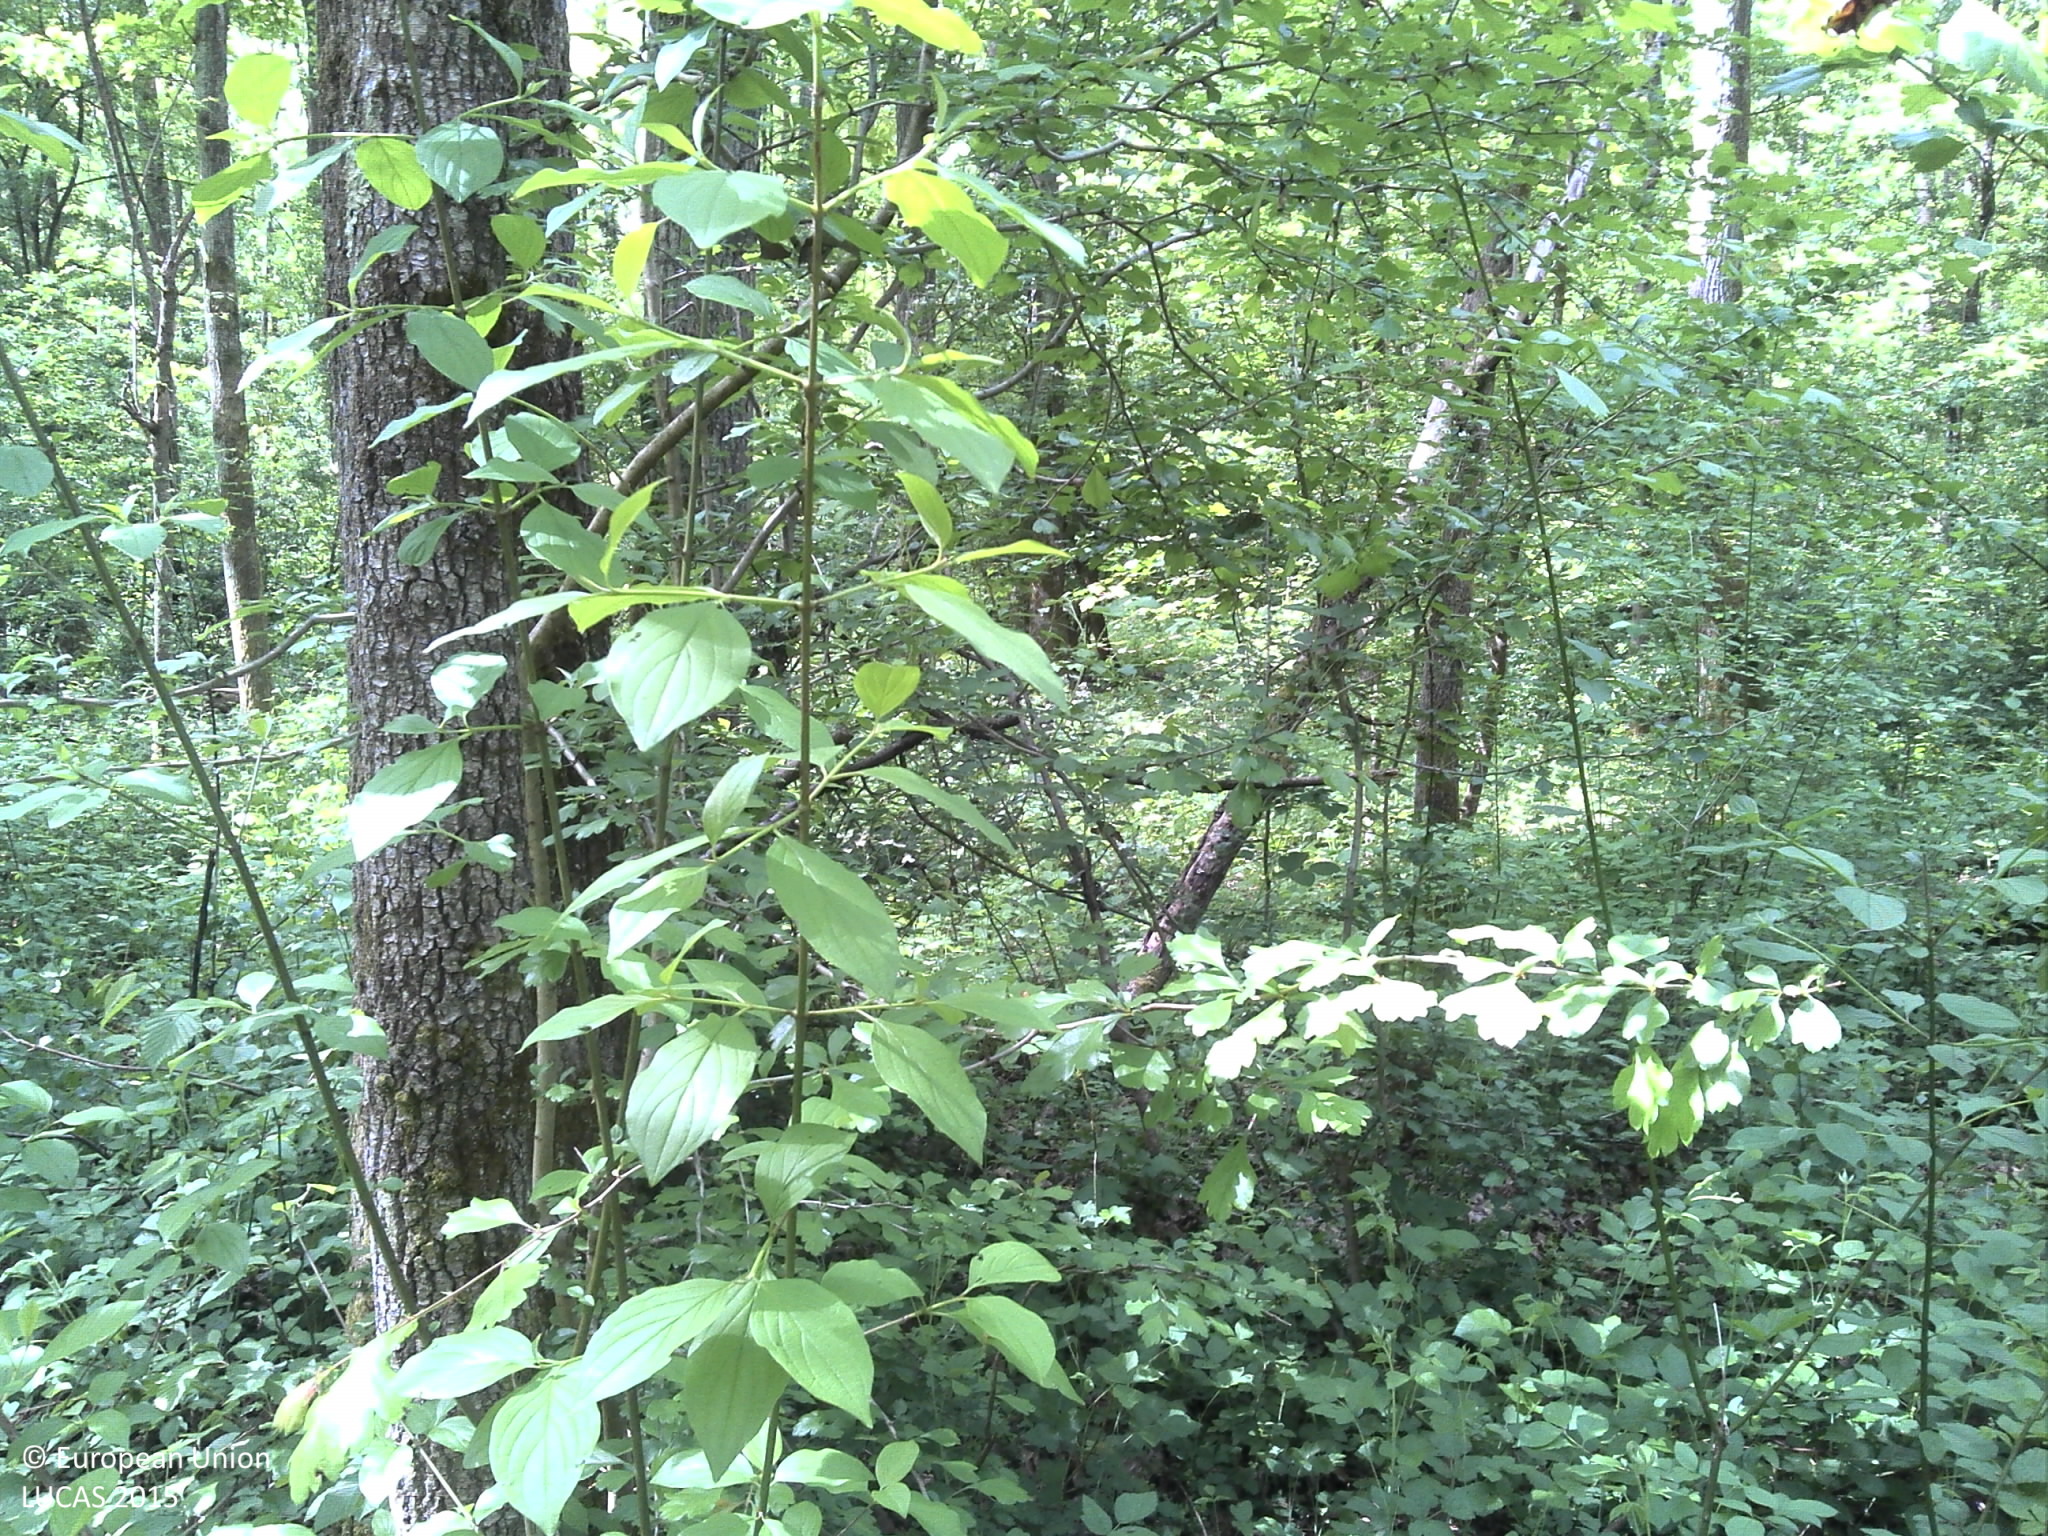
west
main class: Woodland
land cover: Broadleaved woodland
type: acidophilous oak and oak-birch forest
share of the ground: > 75 %
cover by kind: broadleaved forest trees 100 %
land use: Forestry
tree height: > 5 m
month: May
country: HR
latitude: 45.1158
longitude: 18.6110
